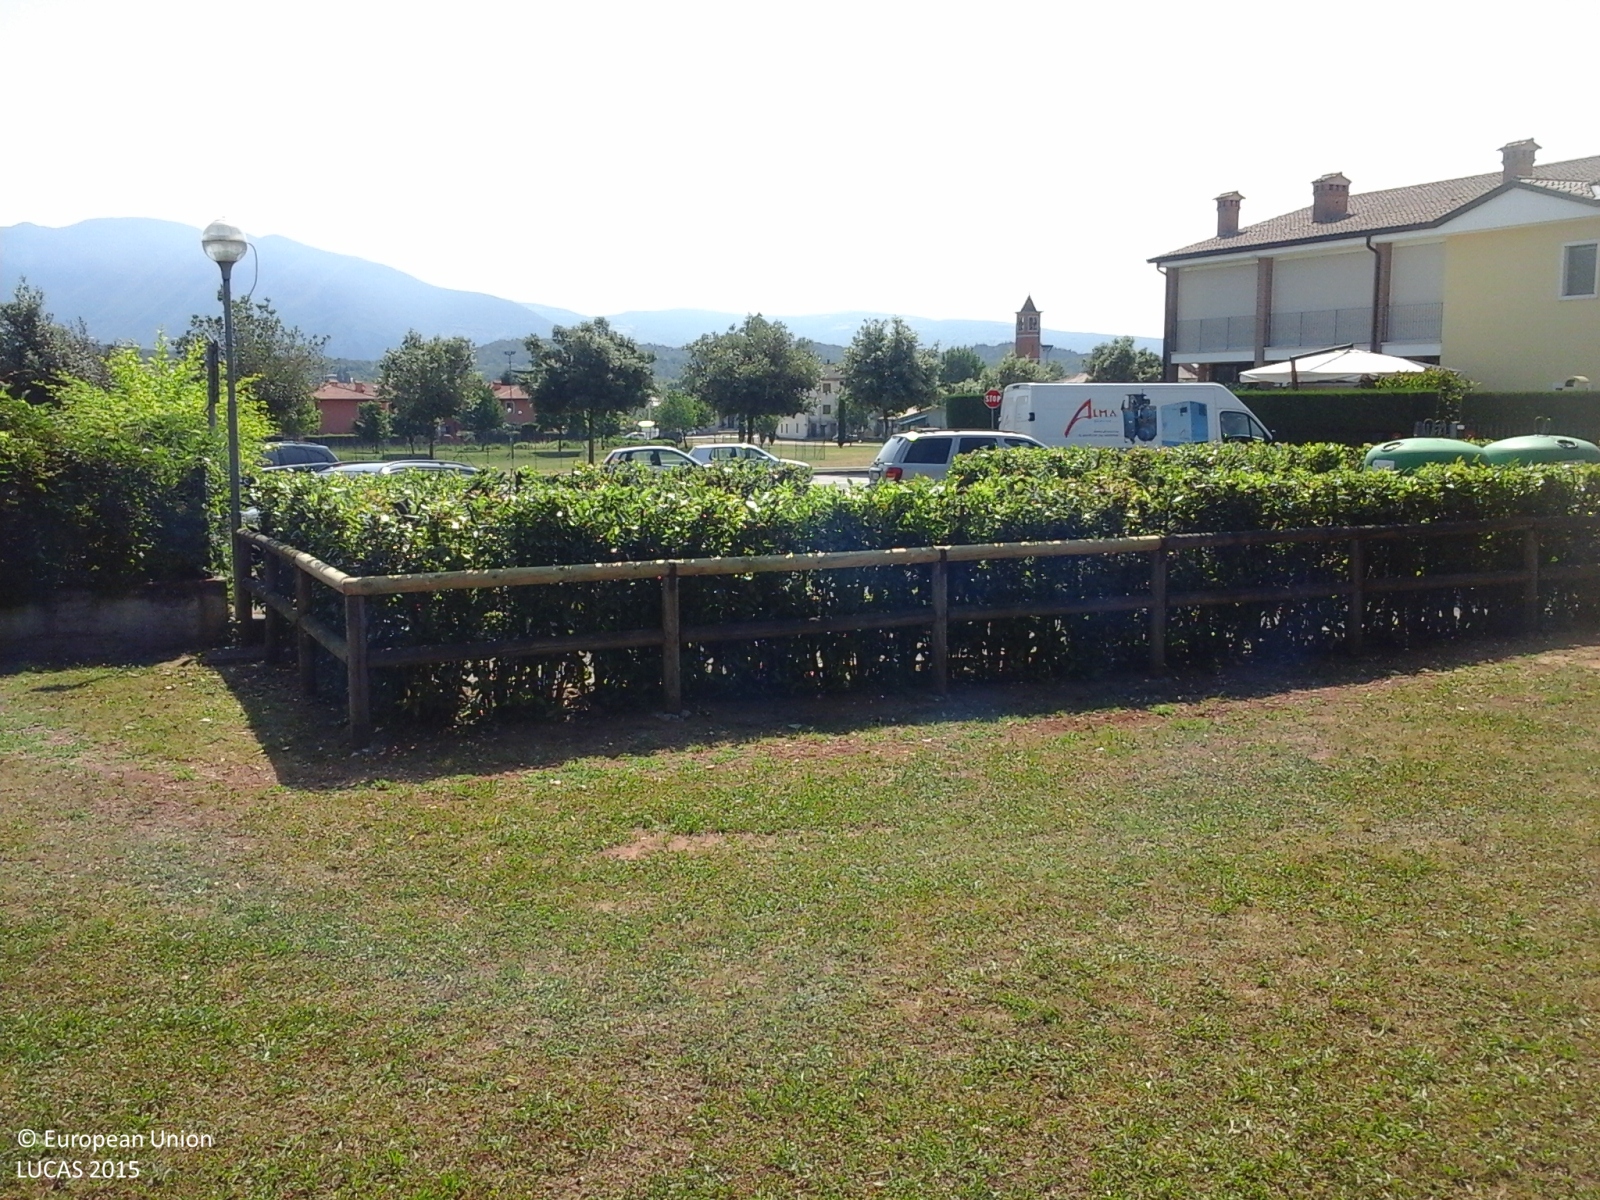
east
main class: Grassland
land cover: Grassland with sparse tree/shrub cover
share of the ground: > 75 %
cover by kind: herbaceous plants 85 %, shrubs 10 %, broadleaved forest trees 5 %
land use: Amenities, museums, leisure
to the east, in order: Grassland with sparse tree/shrub cover; Artificial constructions in urban areas; Lines of trees; Grassland without tree/shrub cover; Electric lines; Grassland with sparse tree/shrub cover; Grassland without tree/shrub cover; Artificial constructions in urban areas
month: June
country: IT
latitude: 45.5738
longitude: 10.7548
